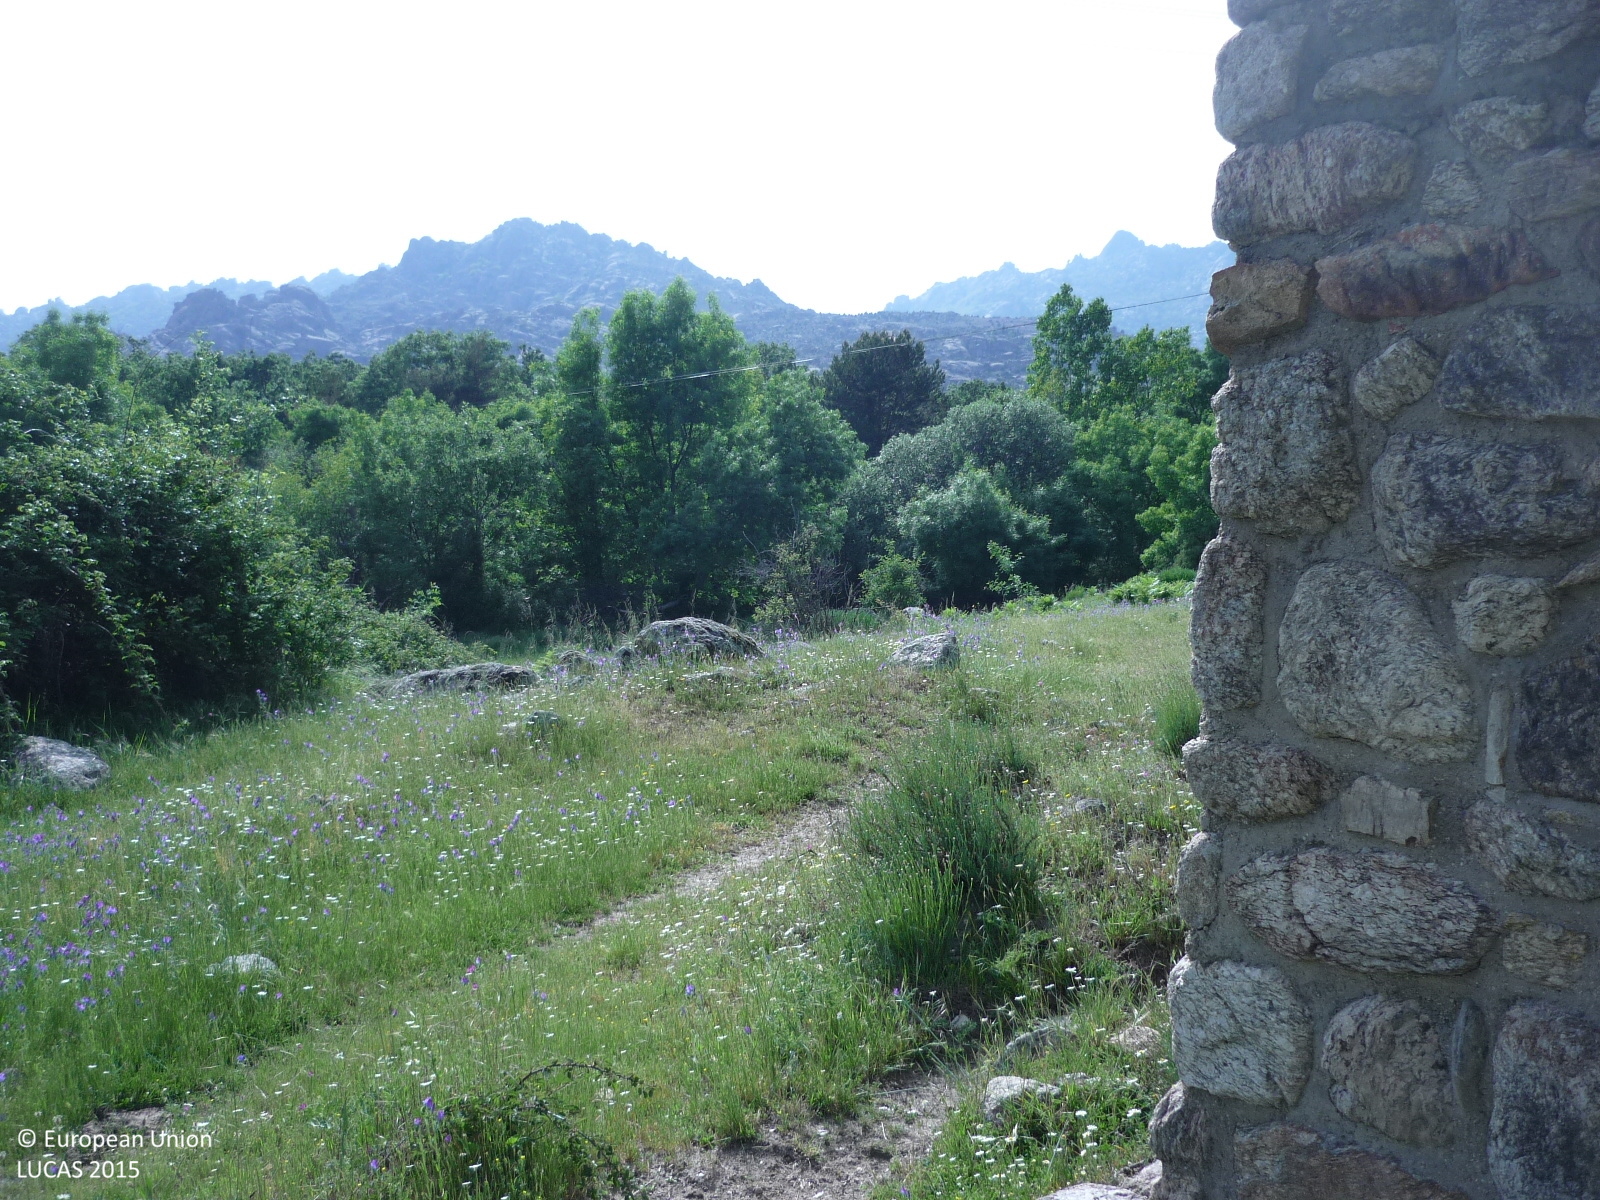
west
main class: Woodland
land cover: Broadleaved woodland
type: thermophilous deciduous forest
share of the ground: > 75 %
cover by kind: broadleaved forest trees 90 %, herbaceous plants 10 %
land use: Semi-natural and natural areas not in use
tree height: > 5 m
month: May
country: ES
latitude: 40.7855
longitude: -3.8257
